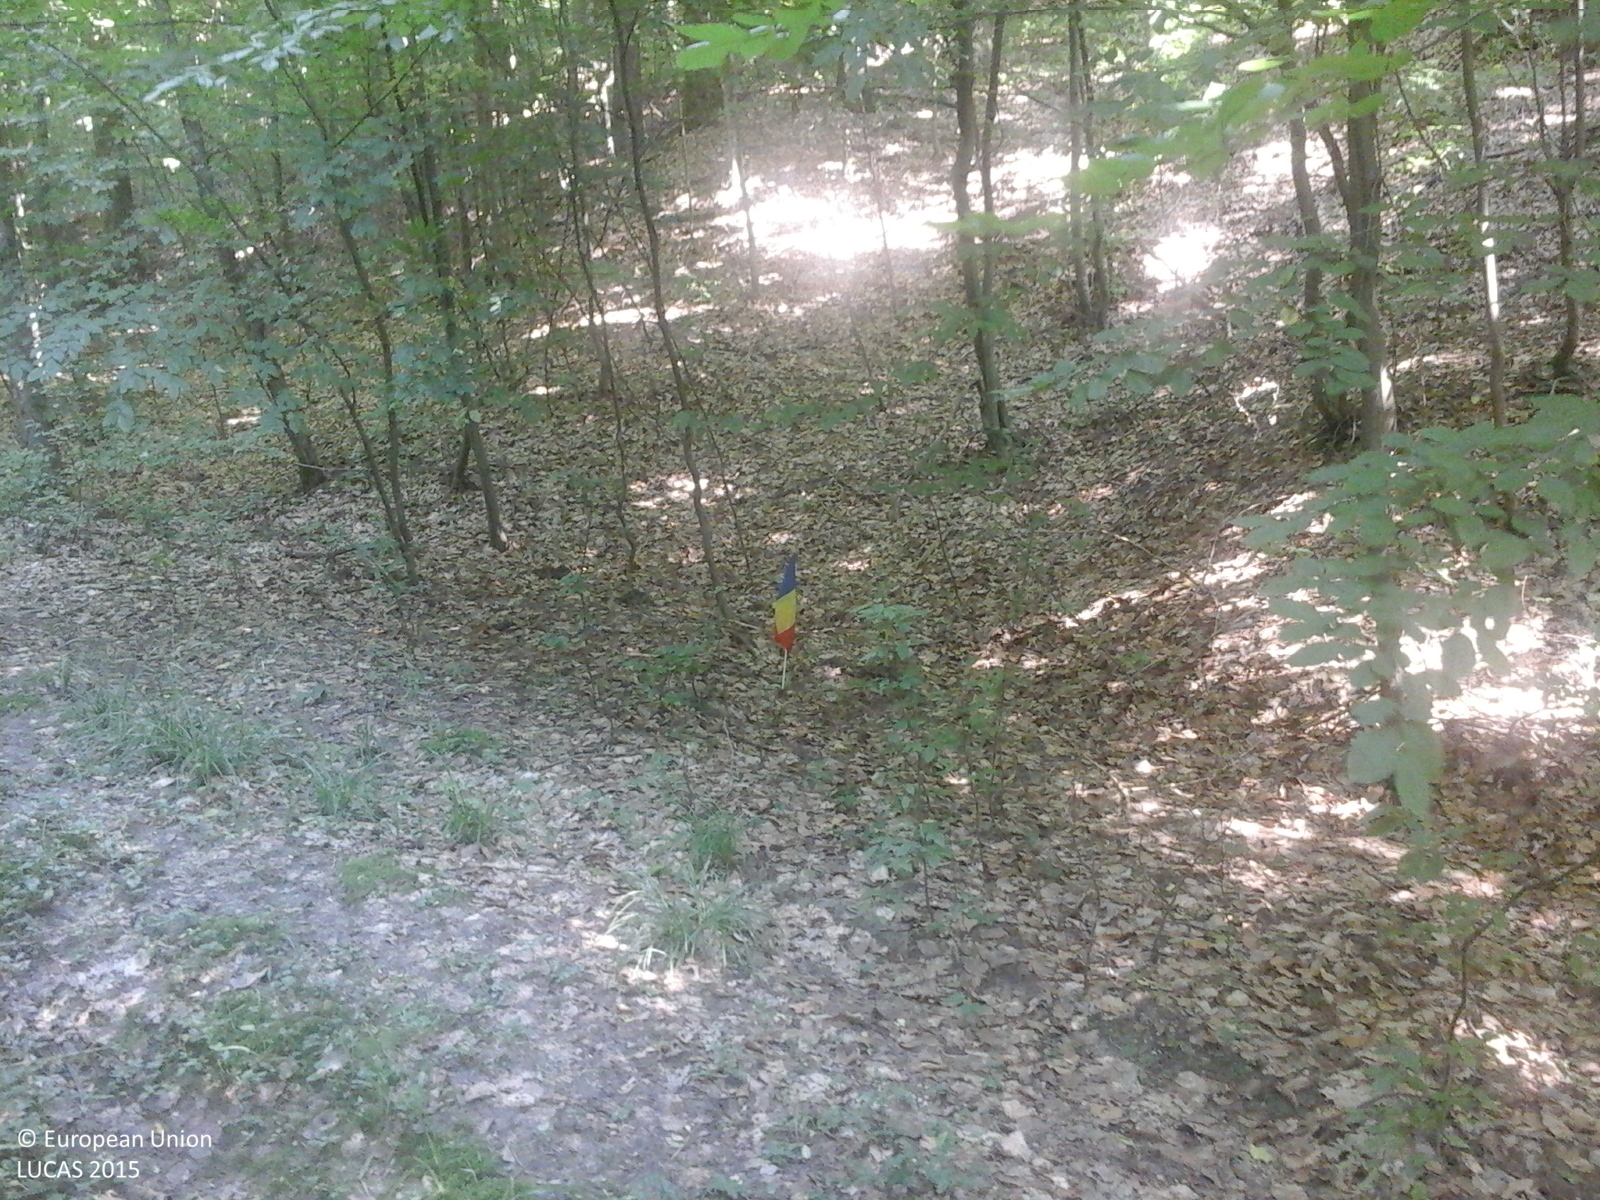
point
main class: Woodland
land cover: Broadleaved woodland
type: mesophytic deciduous forest
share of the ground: > 75 %
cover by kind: broadleaved forest trees 100 %
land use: Forestry
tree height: > 5 m
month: July
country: RO
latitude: 44.7728
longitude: 24.7488
